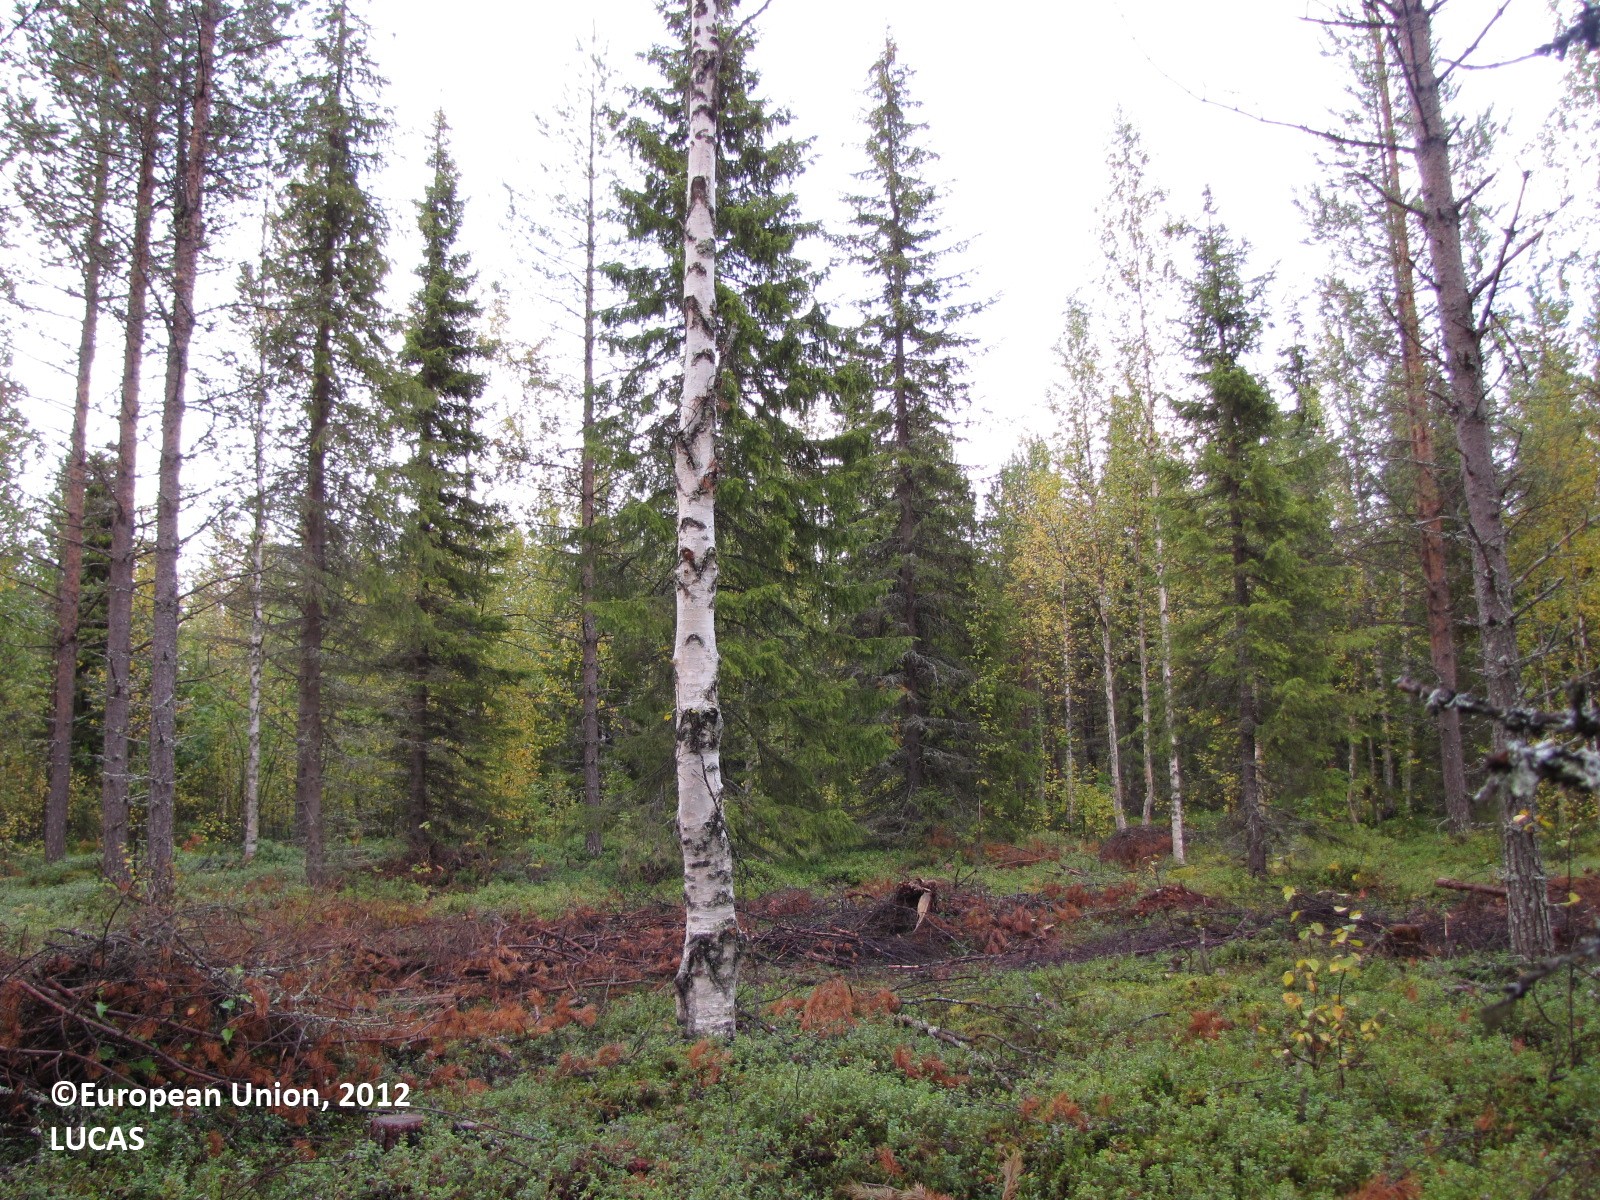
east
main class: Woodland
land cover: Other mixed woodland
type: boreal forest
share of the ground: 10 - 25 %
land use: Forestry
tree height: > 5 m
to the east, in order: Other mixed woodland; Pine dominated mixed woodland; Tracks; Pine dominated mixed woodland; Tracks; Other mixed woodland; Fences; Pine dominated mixed woodland
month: September
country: FI
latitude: 67.2689
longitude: 23.8692
